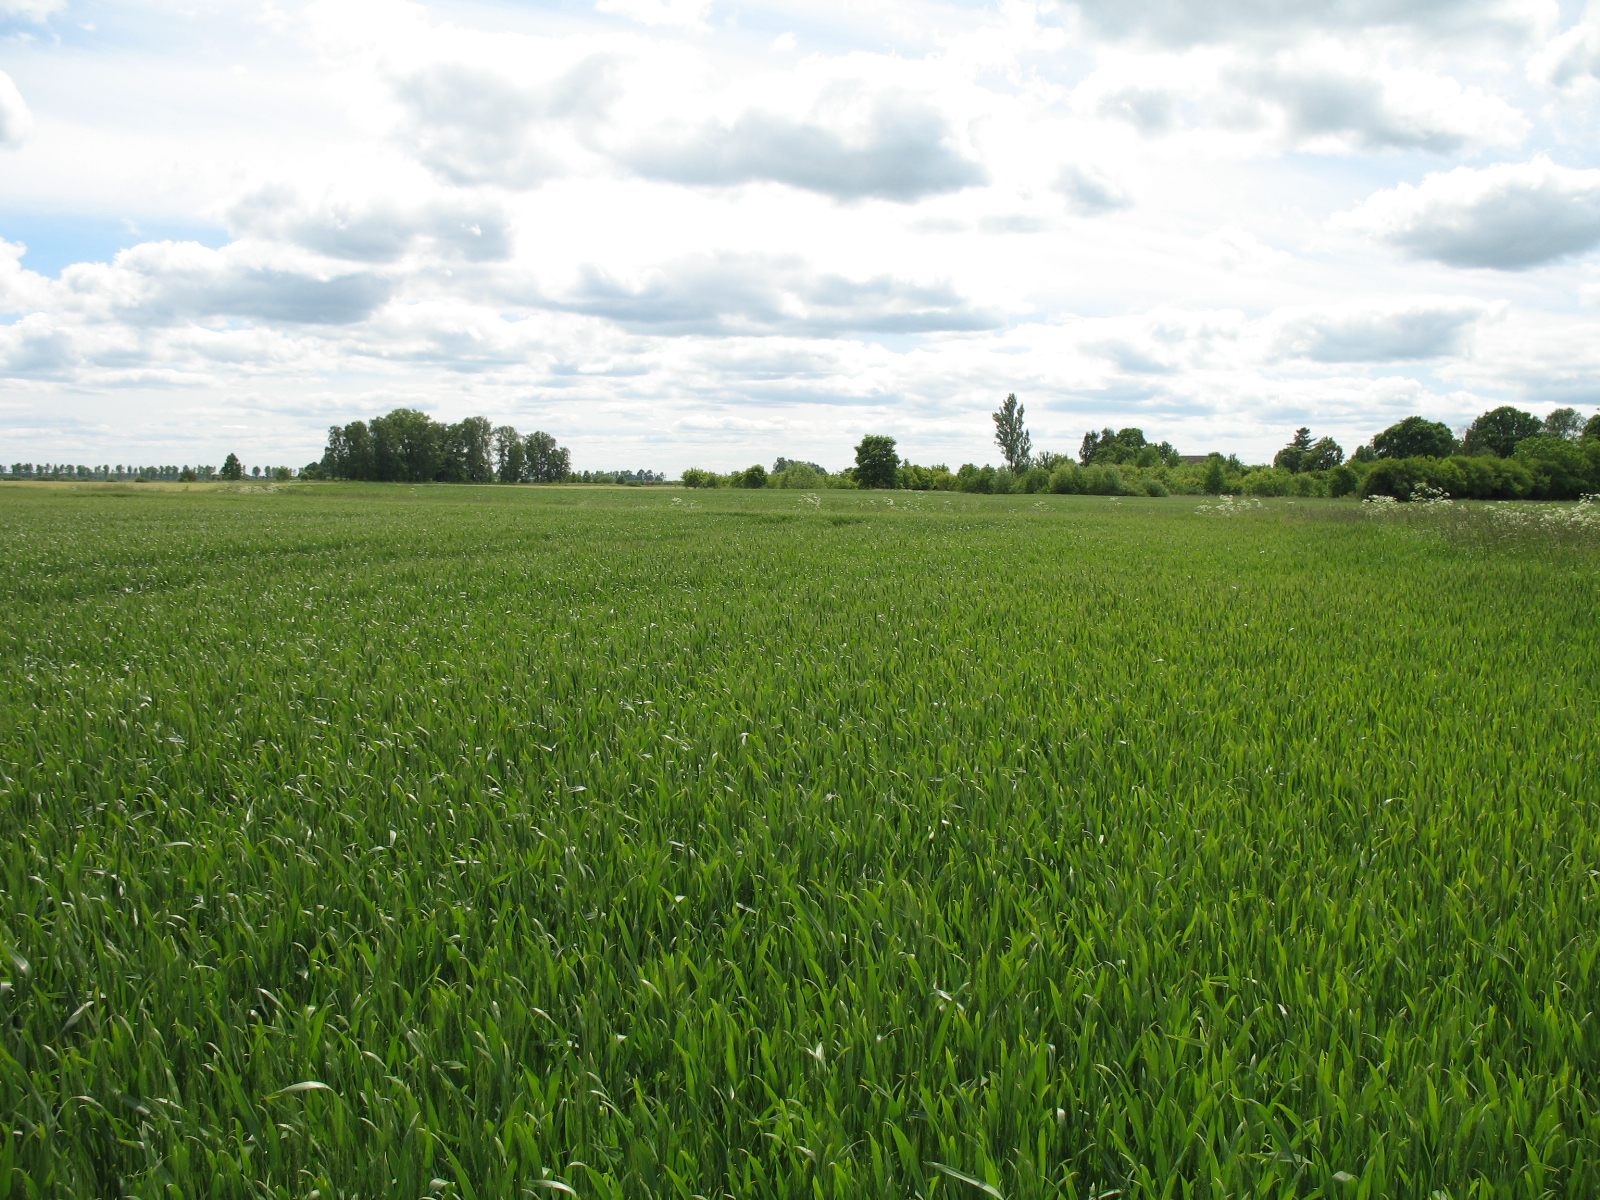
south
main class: Cropland
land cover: Barley
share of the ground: > 75 %
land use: Agriculture (excluding fallow land and kitchen gardens)
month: June
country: LV
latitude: 56.6076
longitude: 23.4489
